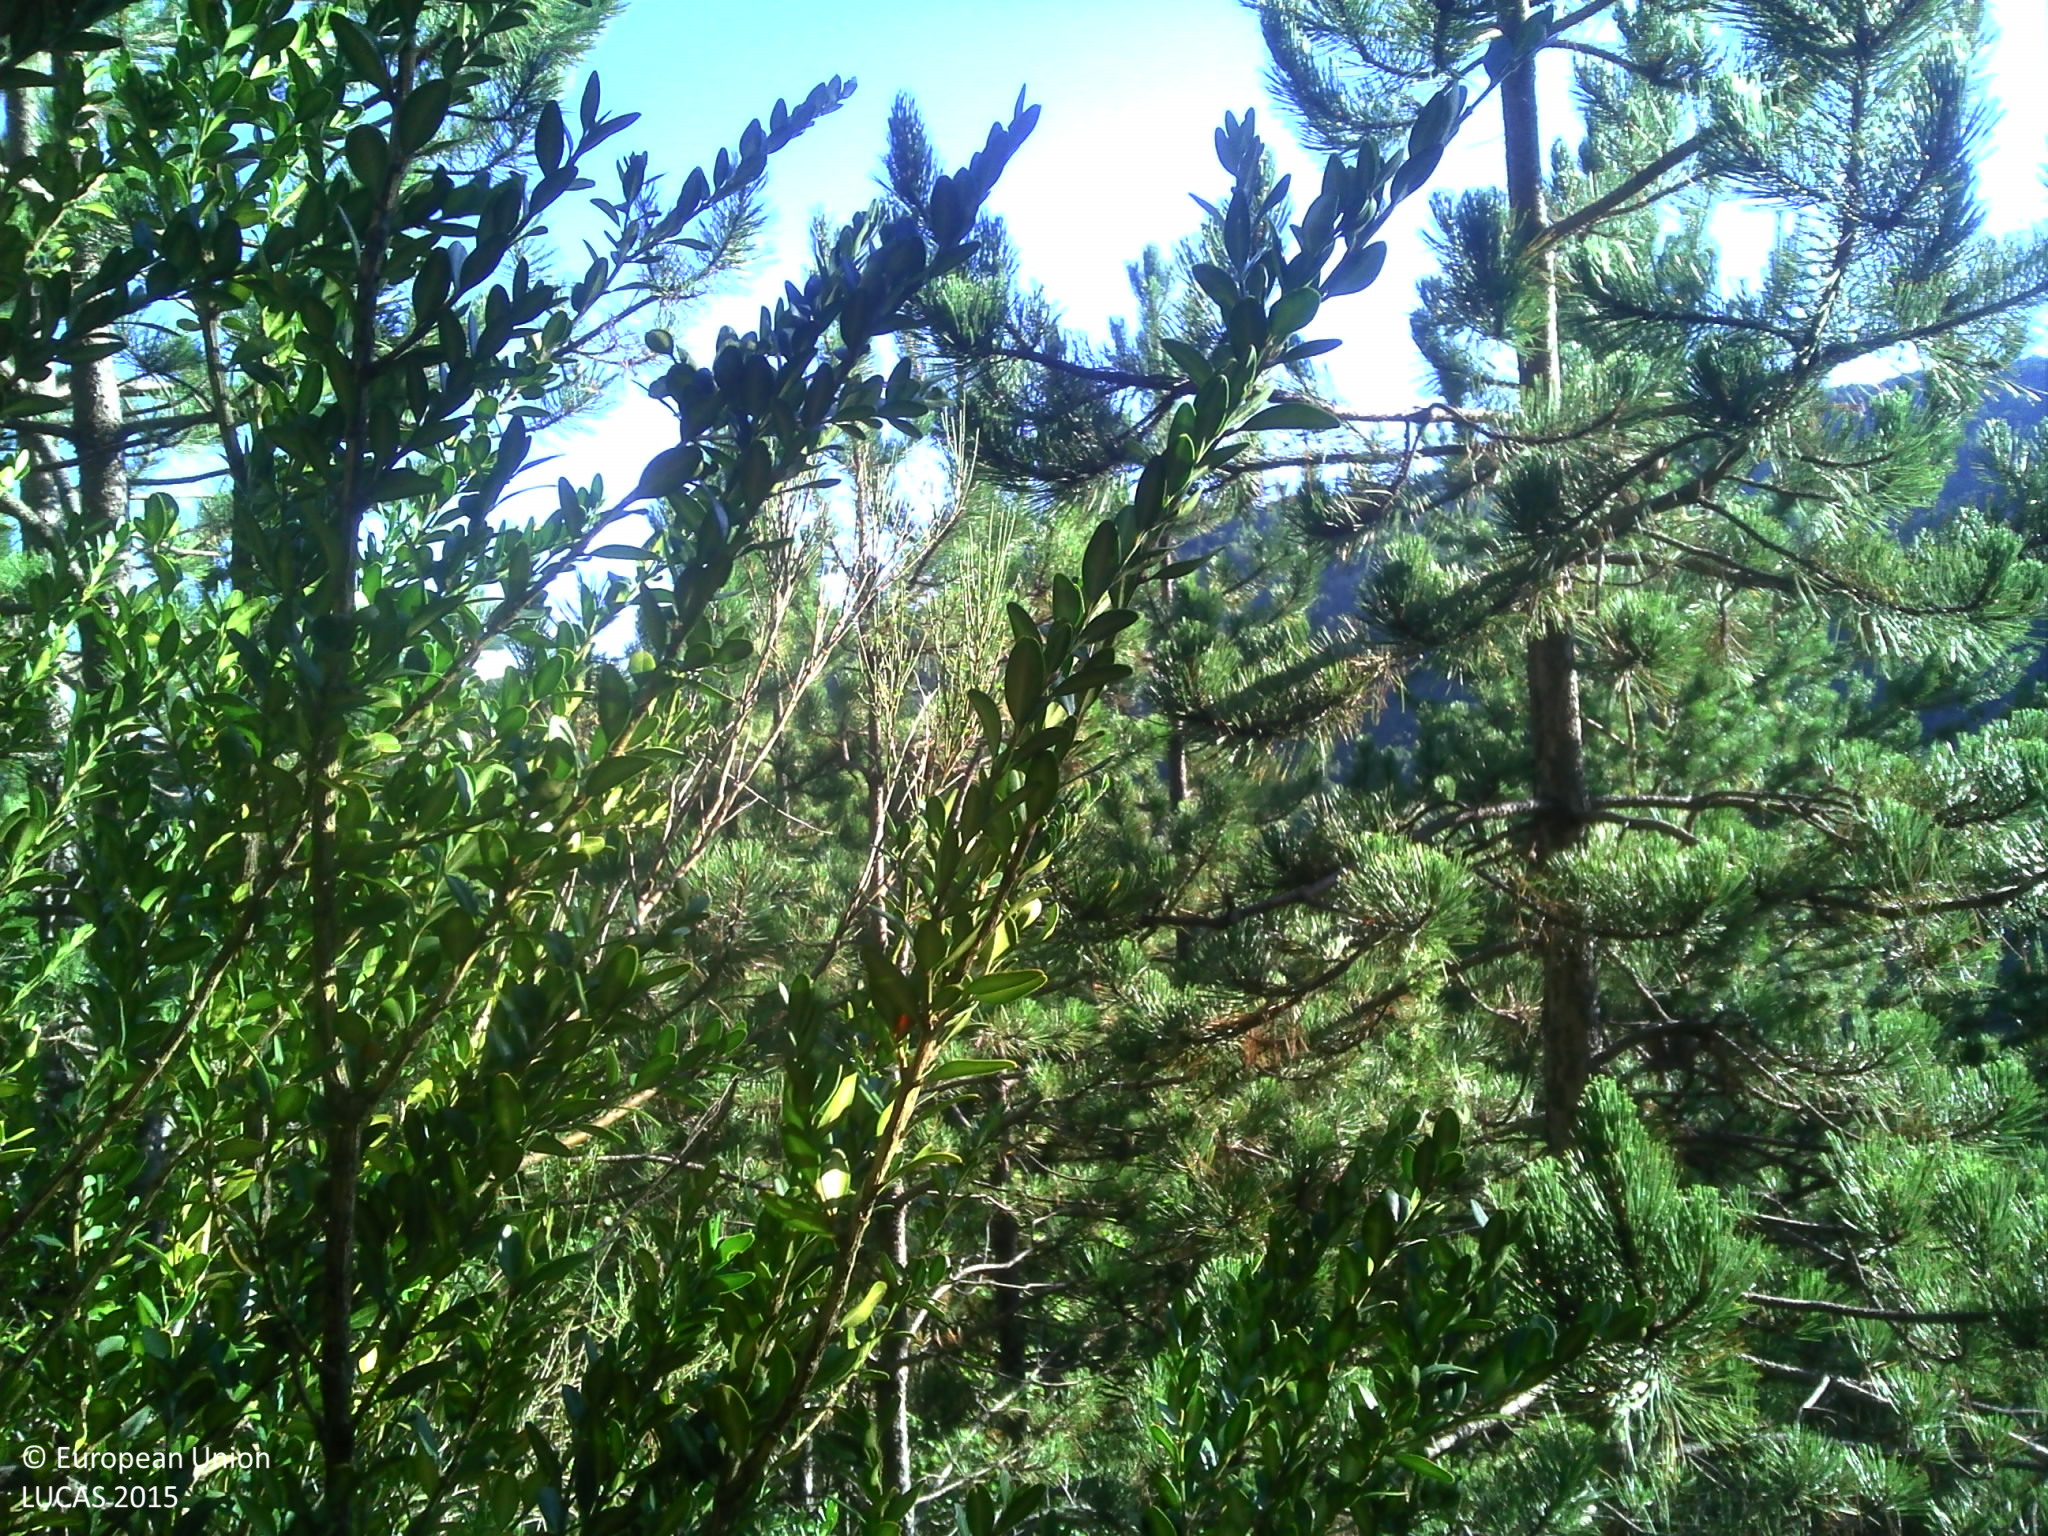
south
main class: Woodland
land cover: Pine dominated mixed woodland
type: coniferous forest of the mediterranean region
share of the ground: > 75 %
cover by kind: coniferous forest trees 50 %, broadleaved forest trees 25 %, herbaceous plants 15 %, unconsolidated bare surface 10 %
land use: Forestry
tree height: > 5 m
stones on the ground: 10 - 25 %
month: August
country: FR
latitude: 44.2147
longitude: 6.3649
